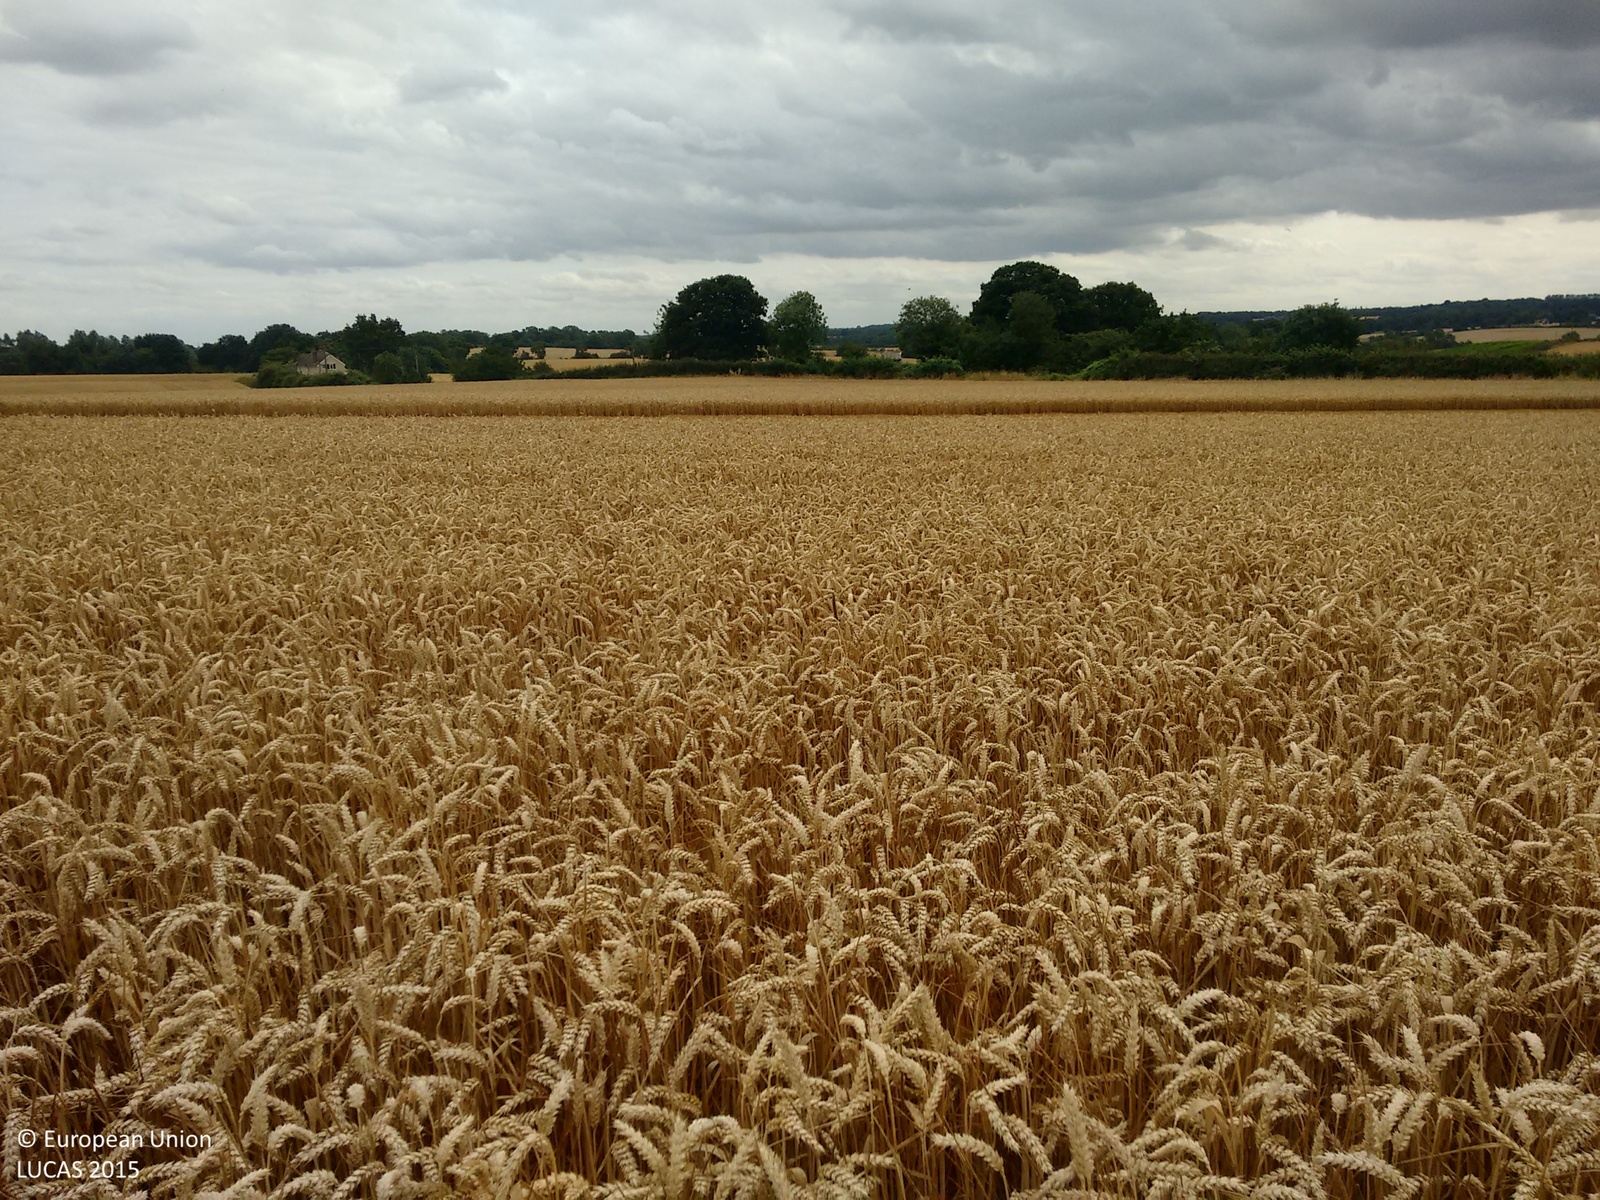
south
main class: Cropland
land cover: Common wheat
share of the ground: > 75 %
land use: Agriculture (excluding fallow land and kitchen gardens)
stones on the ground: 10 - 25 %
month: August
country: GB
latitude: 51.9261
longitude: 0.5349
